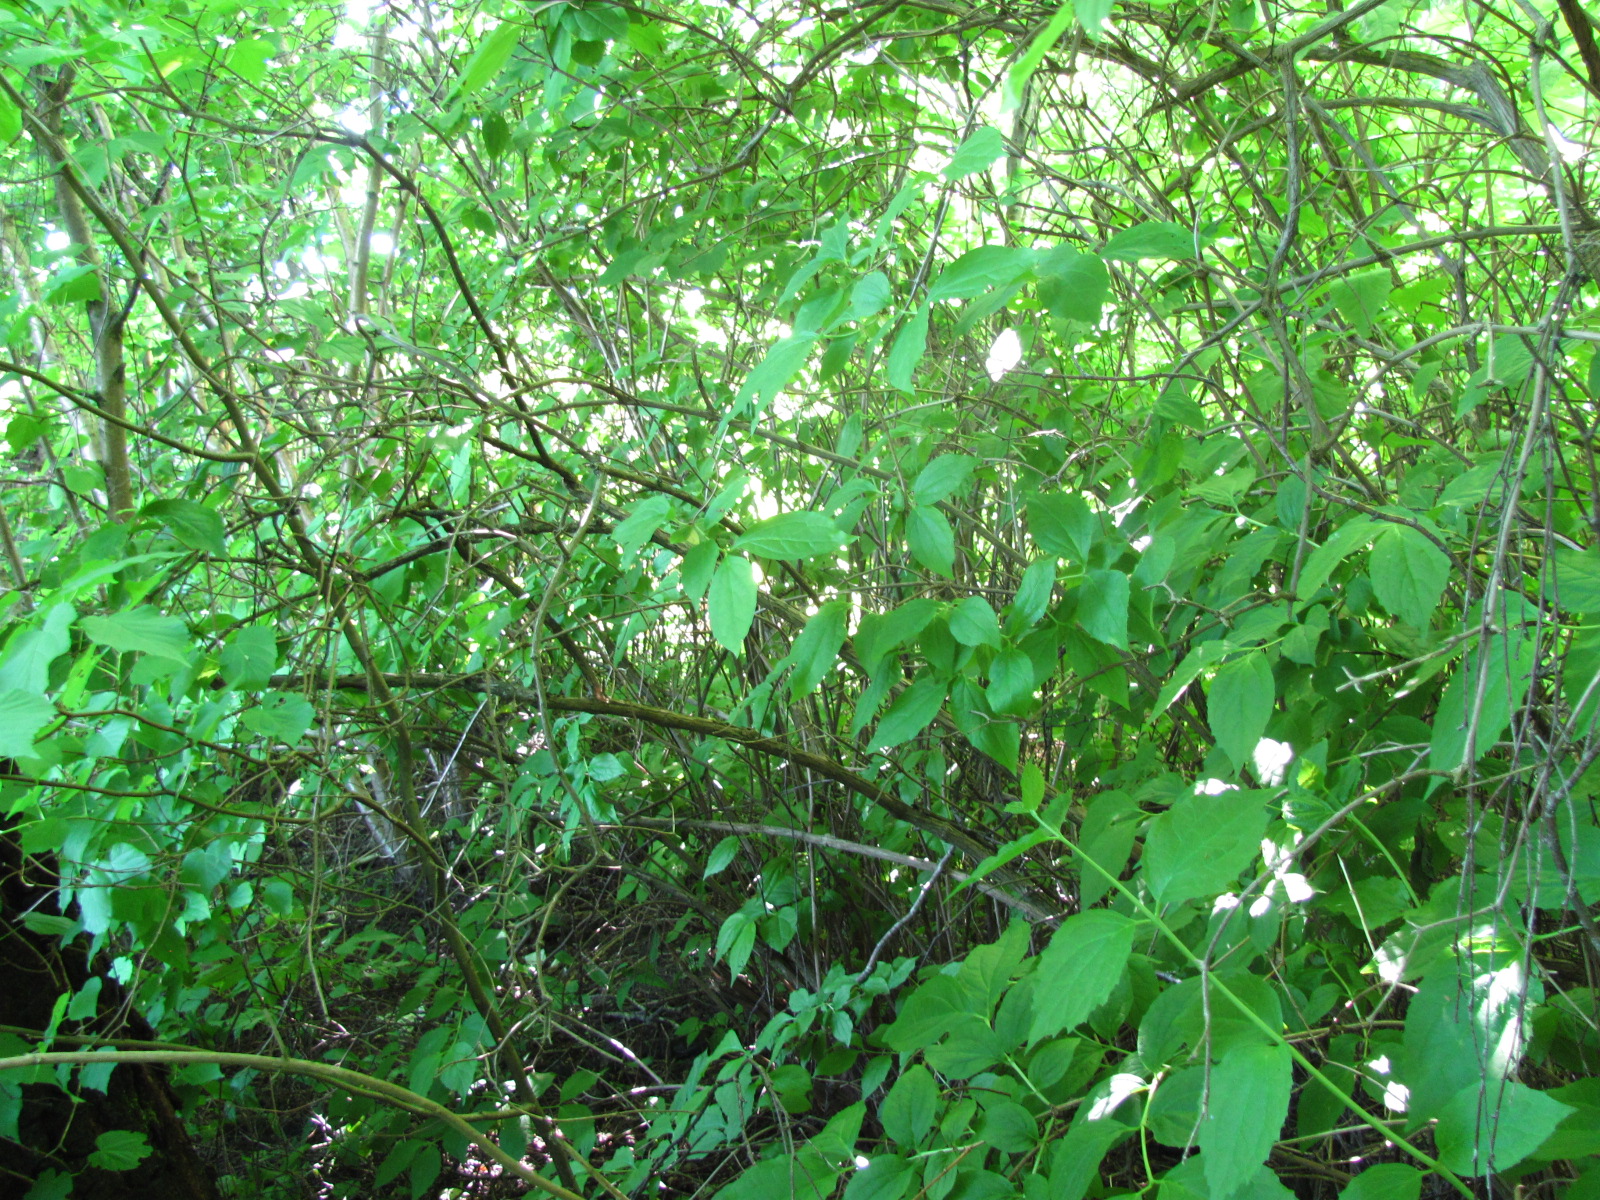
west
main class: Woodland
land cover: Broadleaved woodland
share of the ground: > 75 %
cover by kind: broadleaved forest trees 100 %
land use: Residential
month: June
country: LV
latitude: 56.4475
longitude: 24.2533
